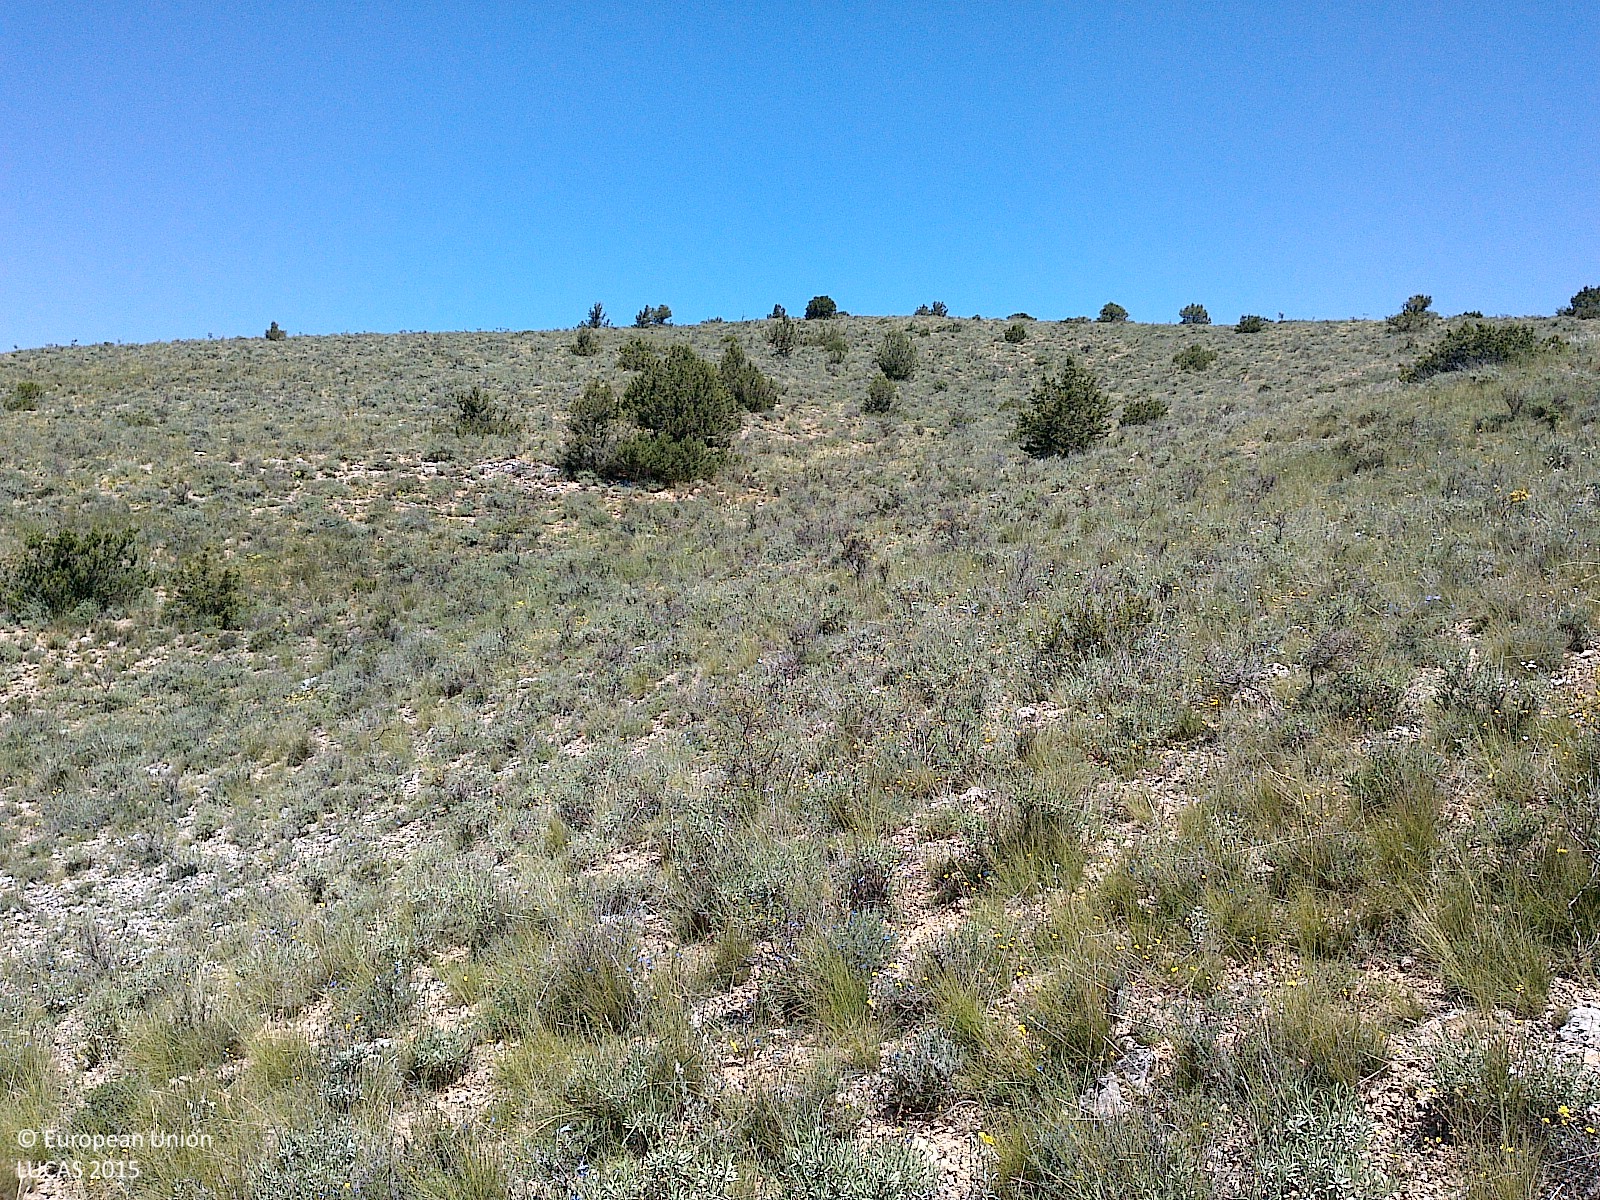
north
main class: Shrubland
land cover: Shrubland without tree cover
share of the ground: 50 - 75 %
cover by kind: shrubs 55 %, consolidated bare surface 35 %, herbaceous plants 10 %
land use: Semi-natural and natural areas not in use
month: May
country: ES
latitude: 41.5676
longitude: -3.0542
